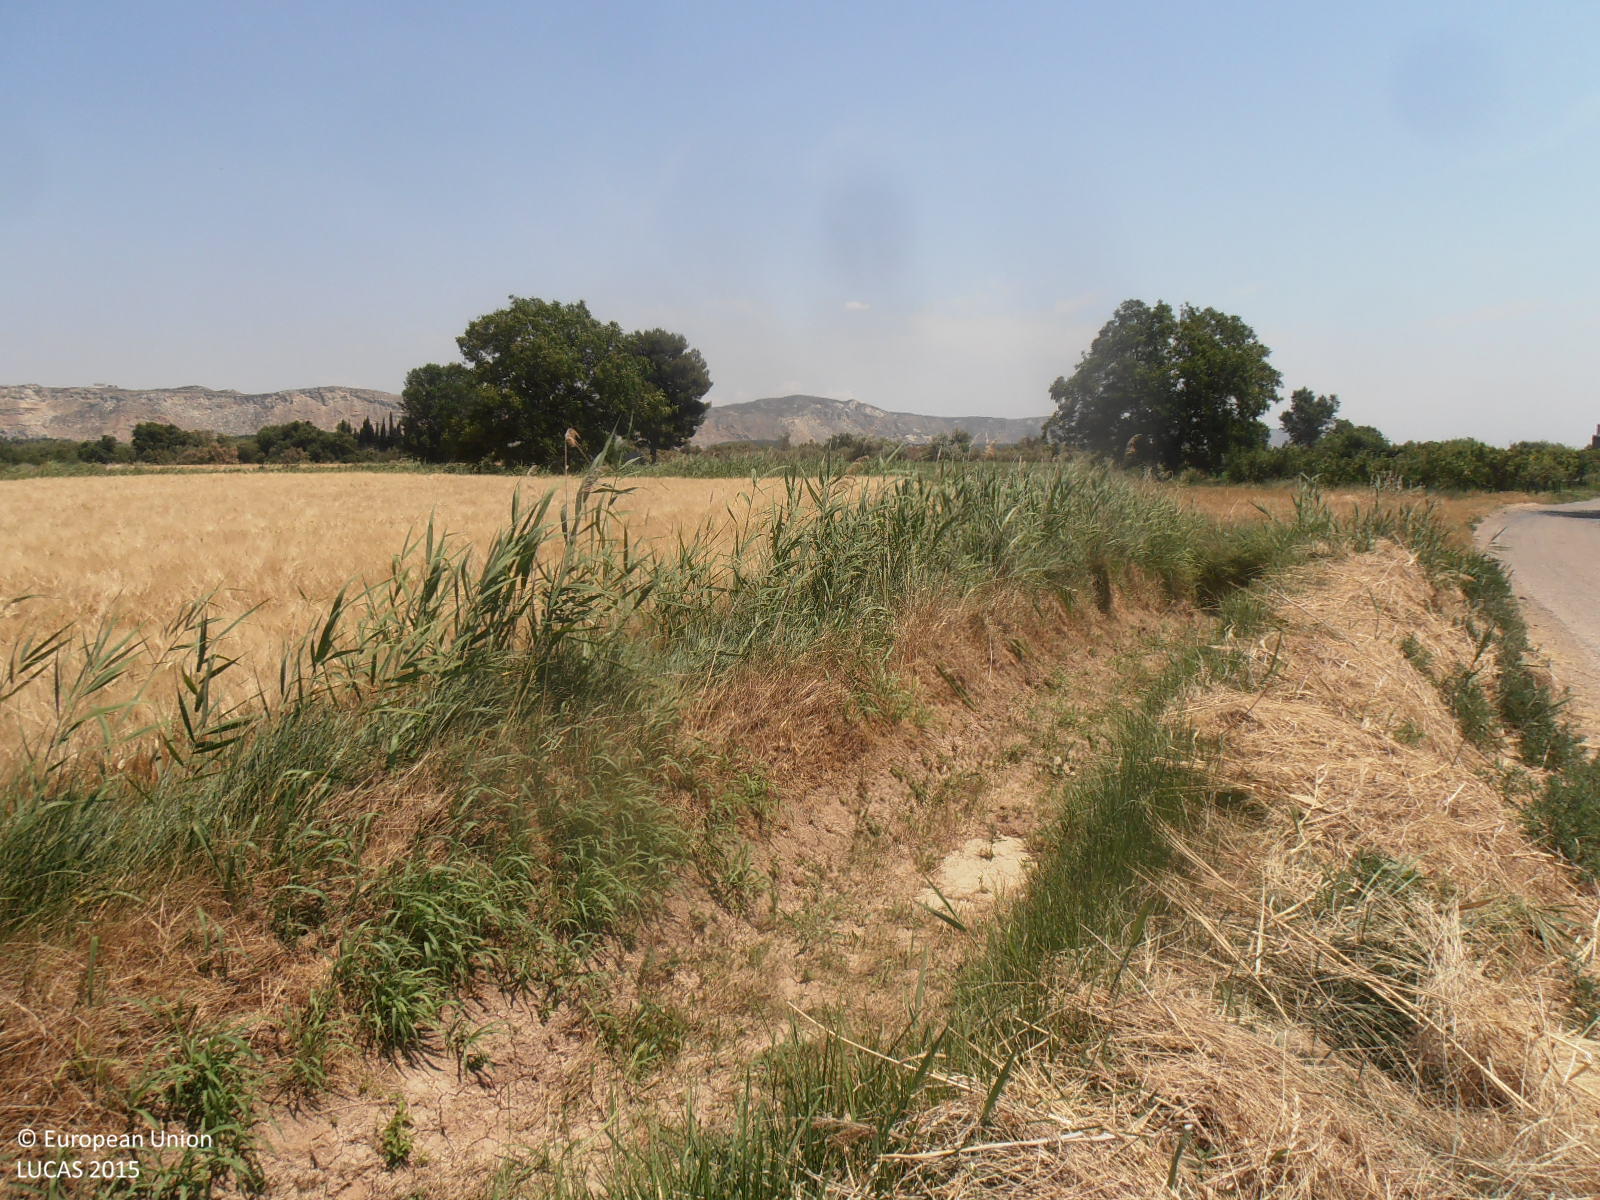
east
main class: Cropland
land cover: Durum wheat
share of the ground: > 75 %
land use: Agriculture (excluding fallow land and kitchen gardens)
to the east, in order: Ditches and canals; Common wheat; Shruby margins; Ditches and canals; Single bushes/trees; Lucerne; Shruby margins; Lucerne; Grass margins; Lucerne; Single bushes/trees; Tracks; Grass margins; Common wheat; Grass margins; Tracks; Abandoned hedges; Olive groves; Abandoned hedges
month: June
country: ES
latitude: 41.7710
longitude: -1.0798
